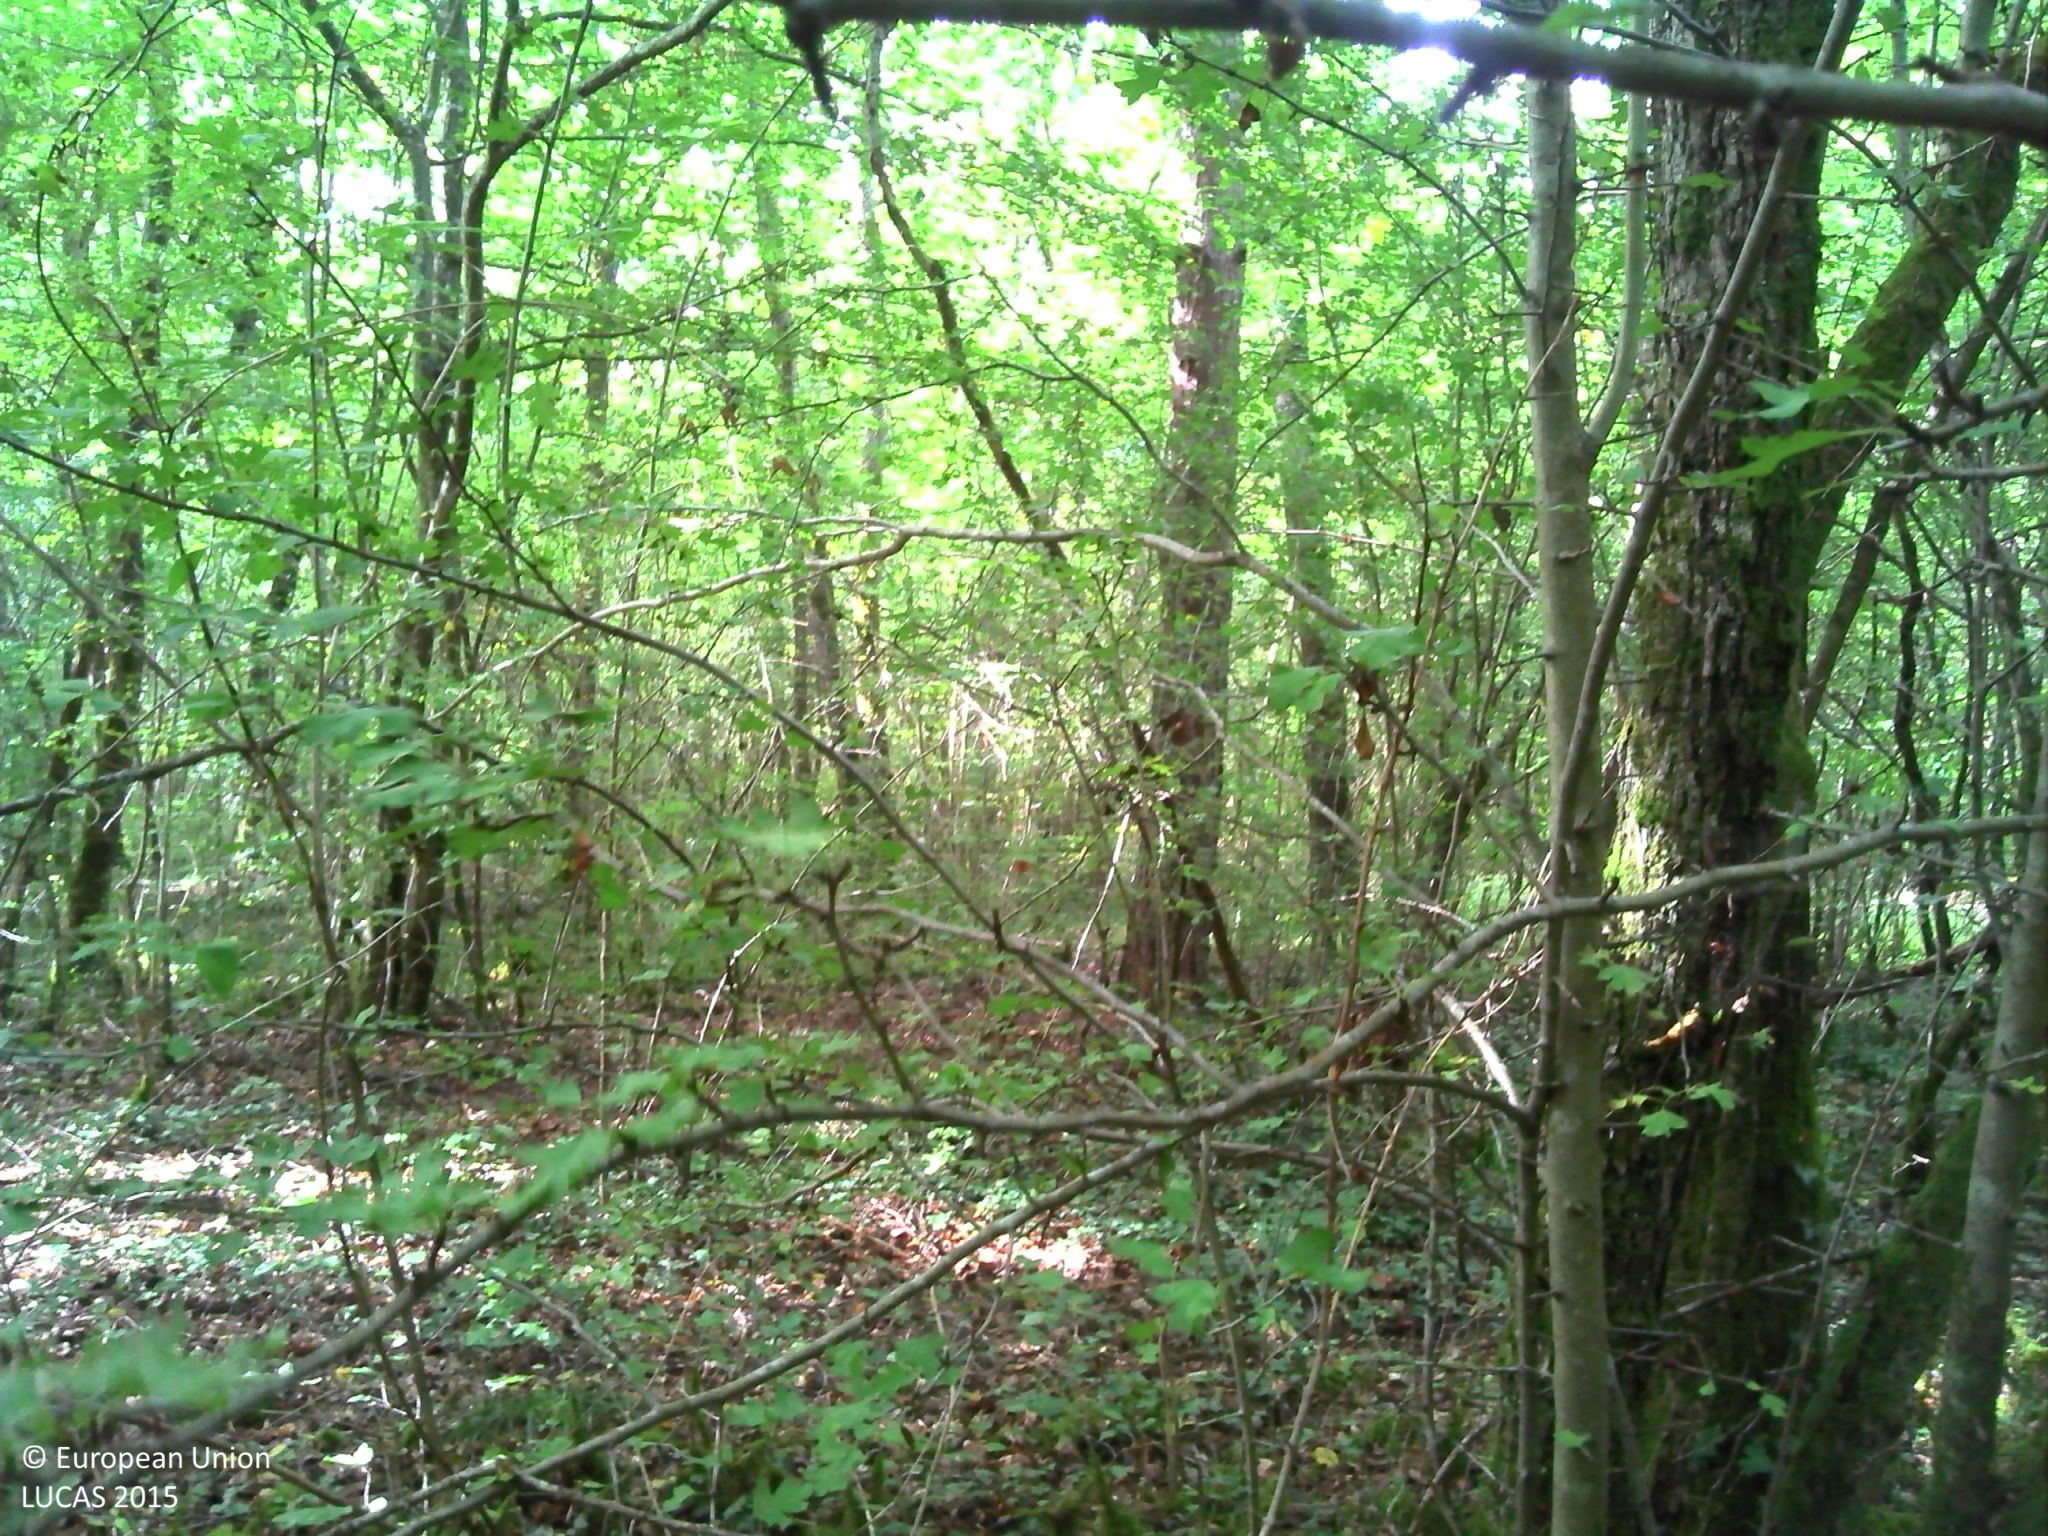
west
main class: Woodland
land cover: Broadleaved woodland
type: mesophytic deciduous forest
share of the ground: > 75 %
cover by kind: broadleaved forest trees 80 %, shrubs 10 %, herbaceous plants 10 %
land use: Forestry
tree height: > 5 m
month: September
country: FR
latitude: 48.2580
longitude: 2.7850
